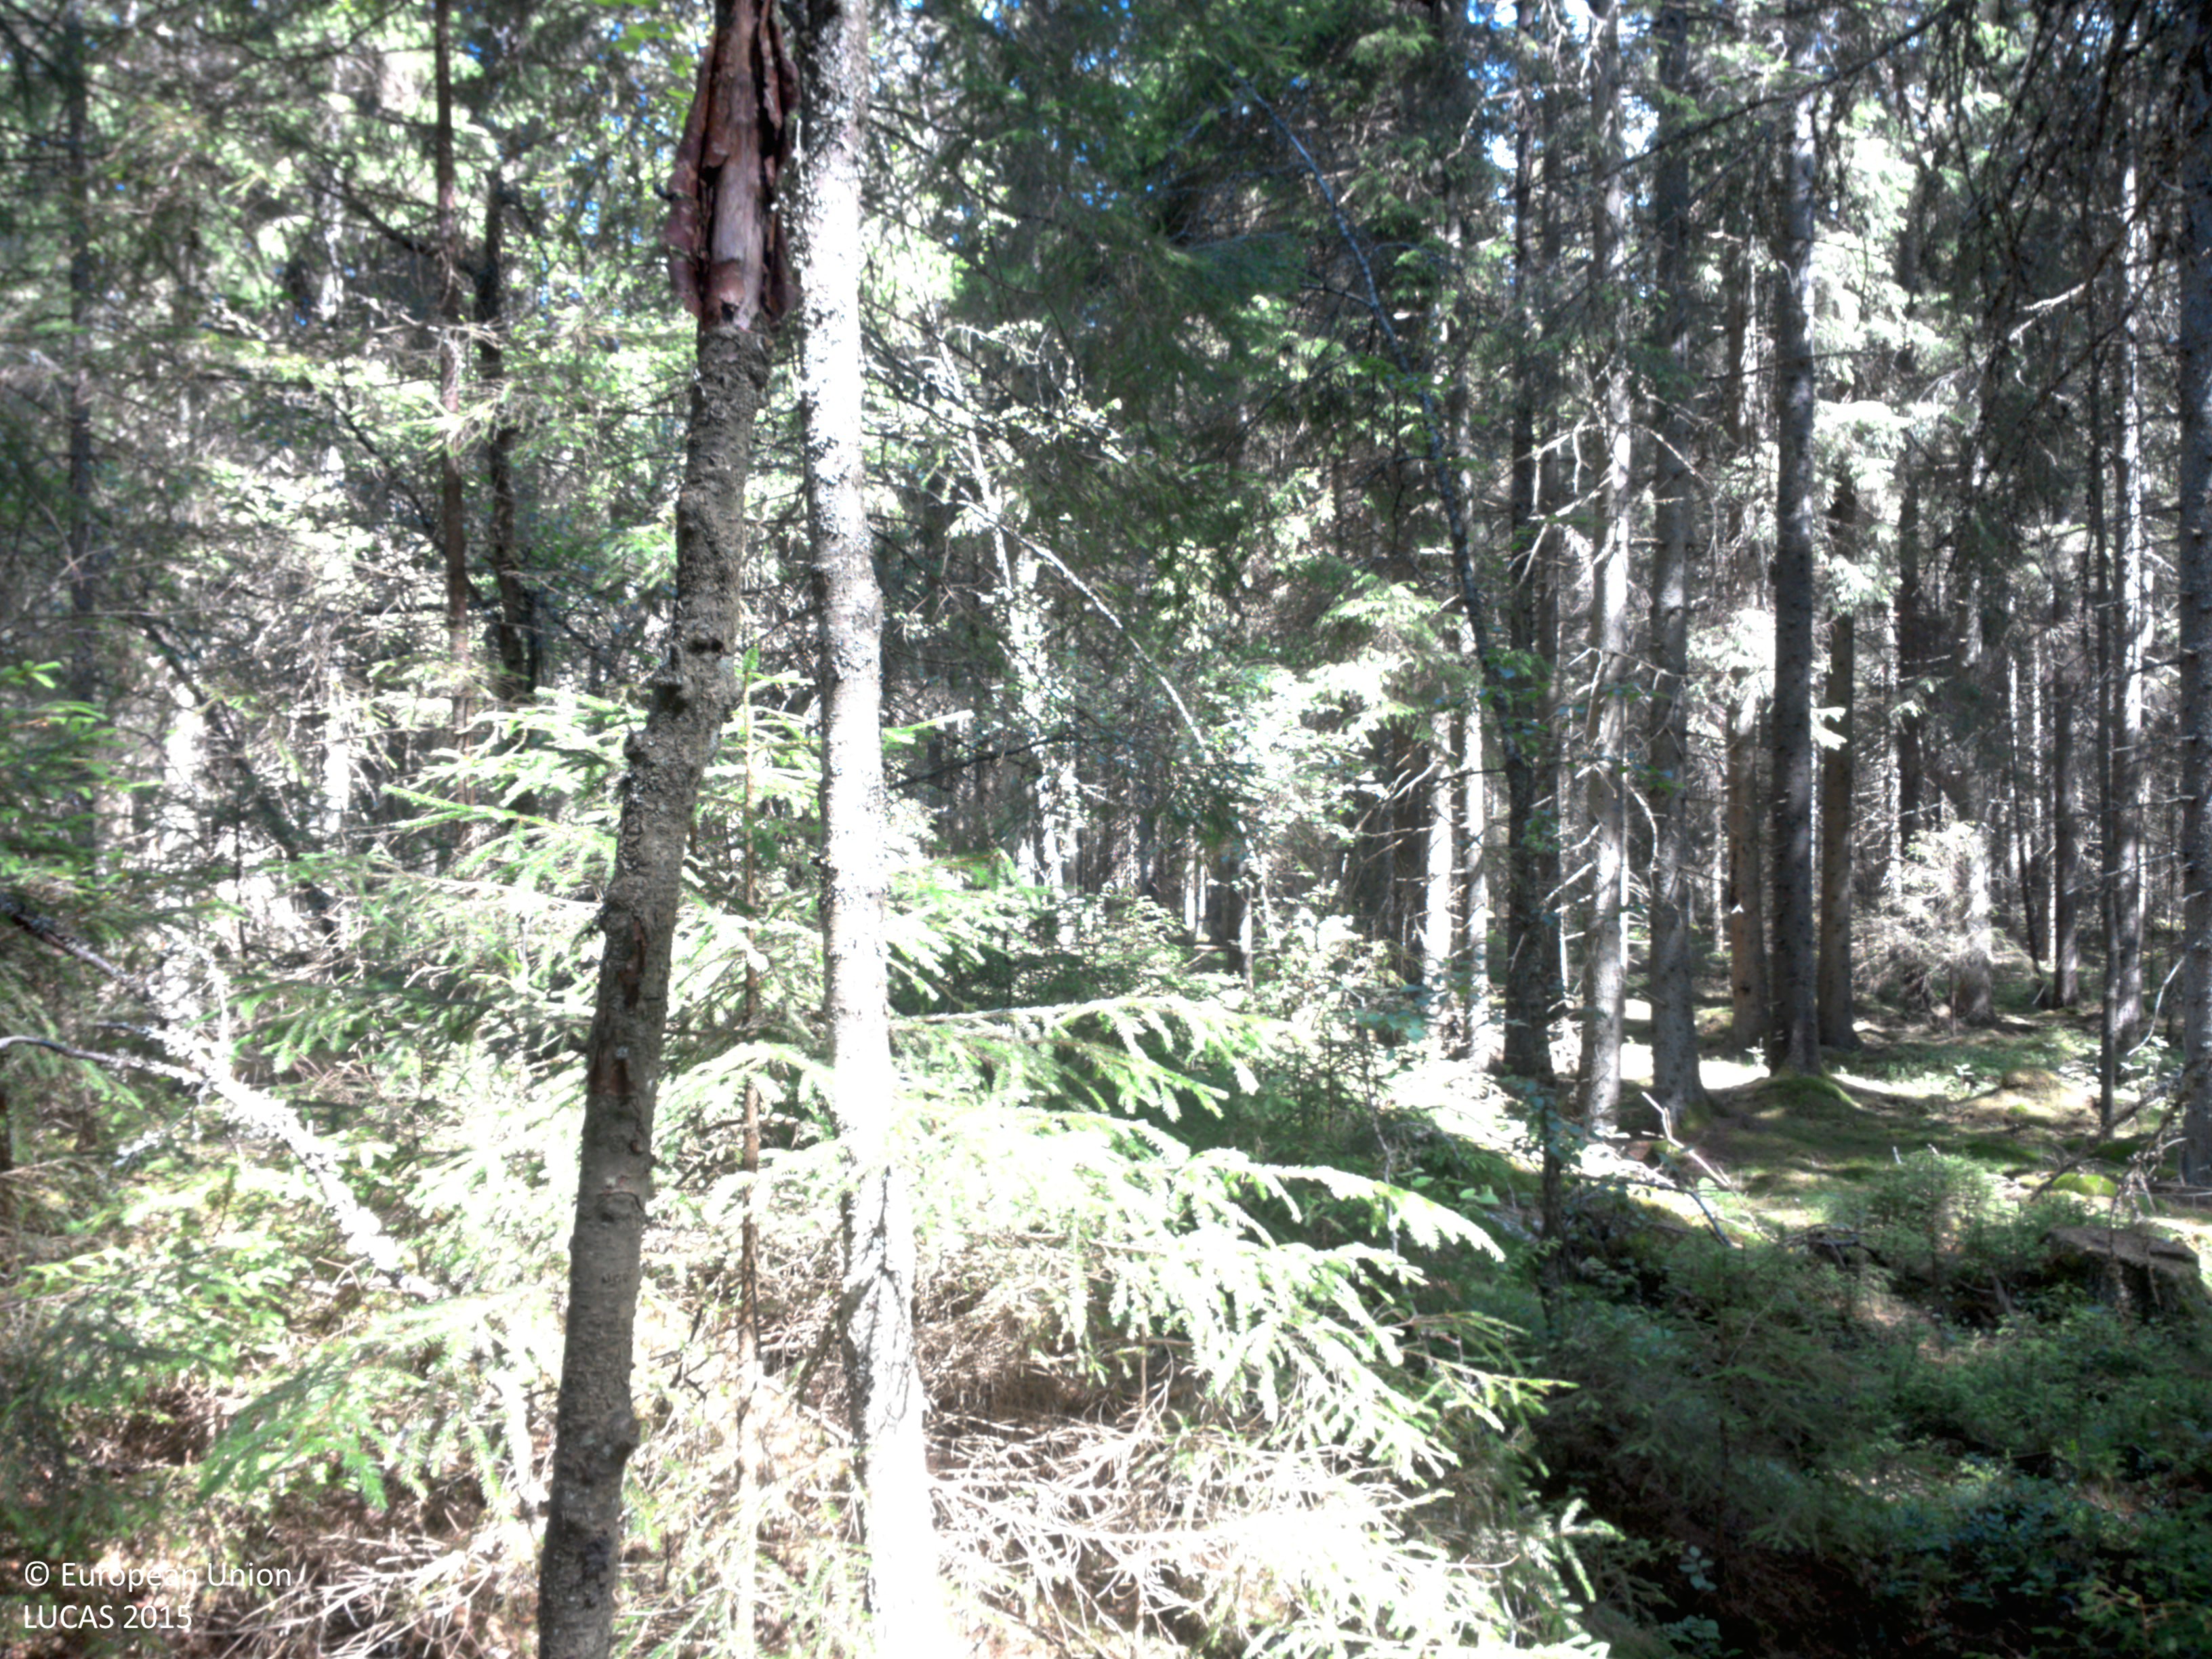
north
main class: Woodland
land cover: Spruce dominated coniferous woodland
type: boreal forest
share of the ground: 50 - 75 %
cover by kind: coniferous forest trees 75 %, lichens and mosses 25 %
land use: Forestry
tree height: > 5 m
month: July
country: SE
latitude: 58.8001
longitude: 11.8822
